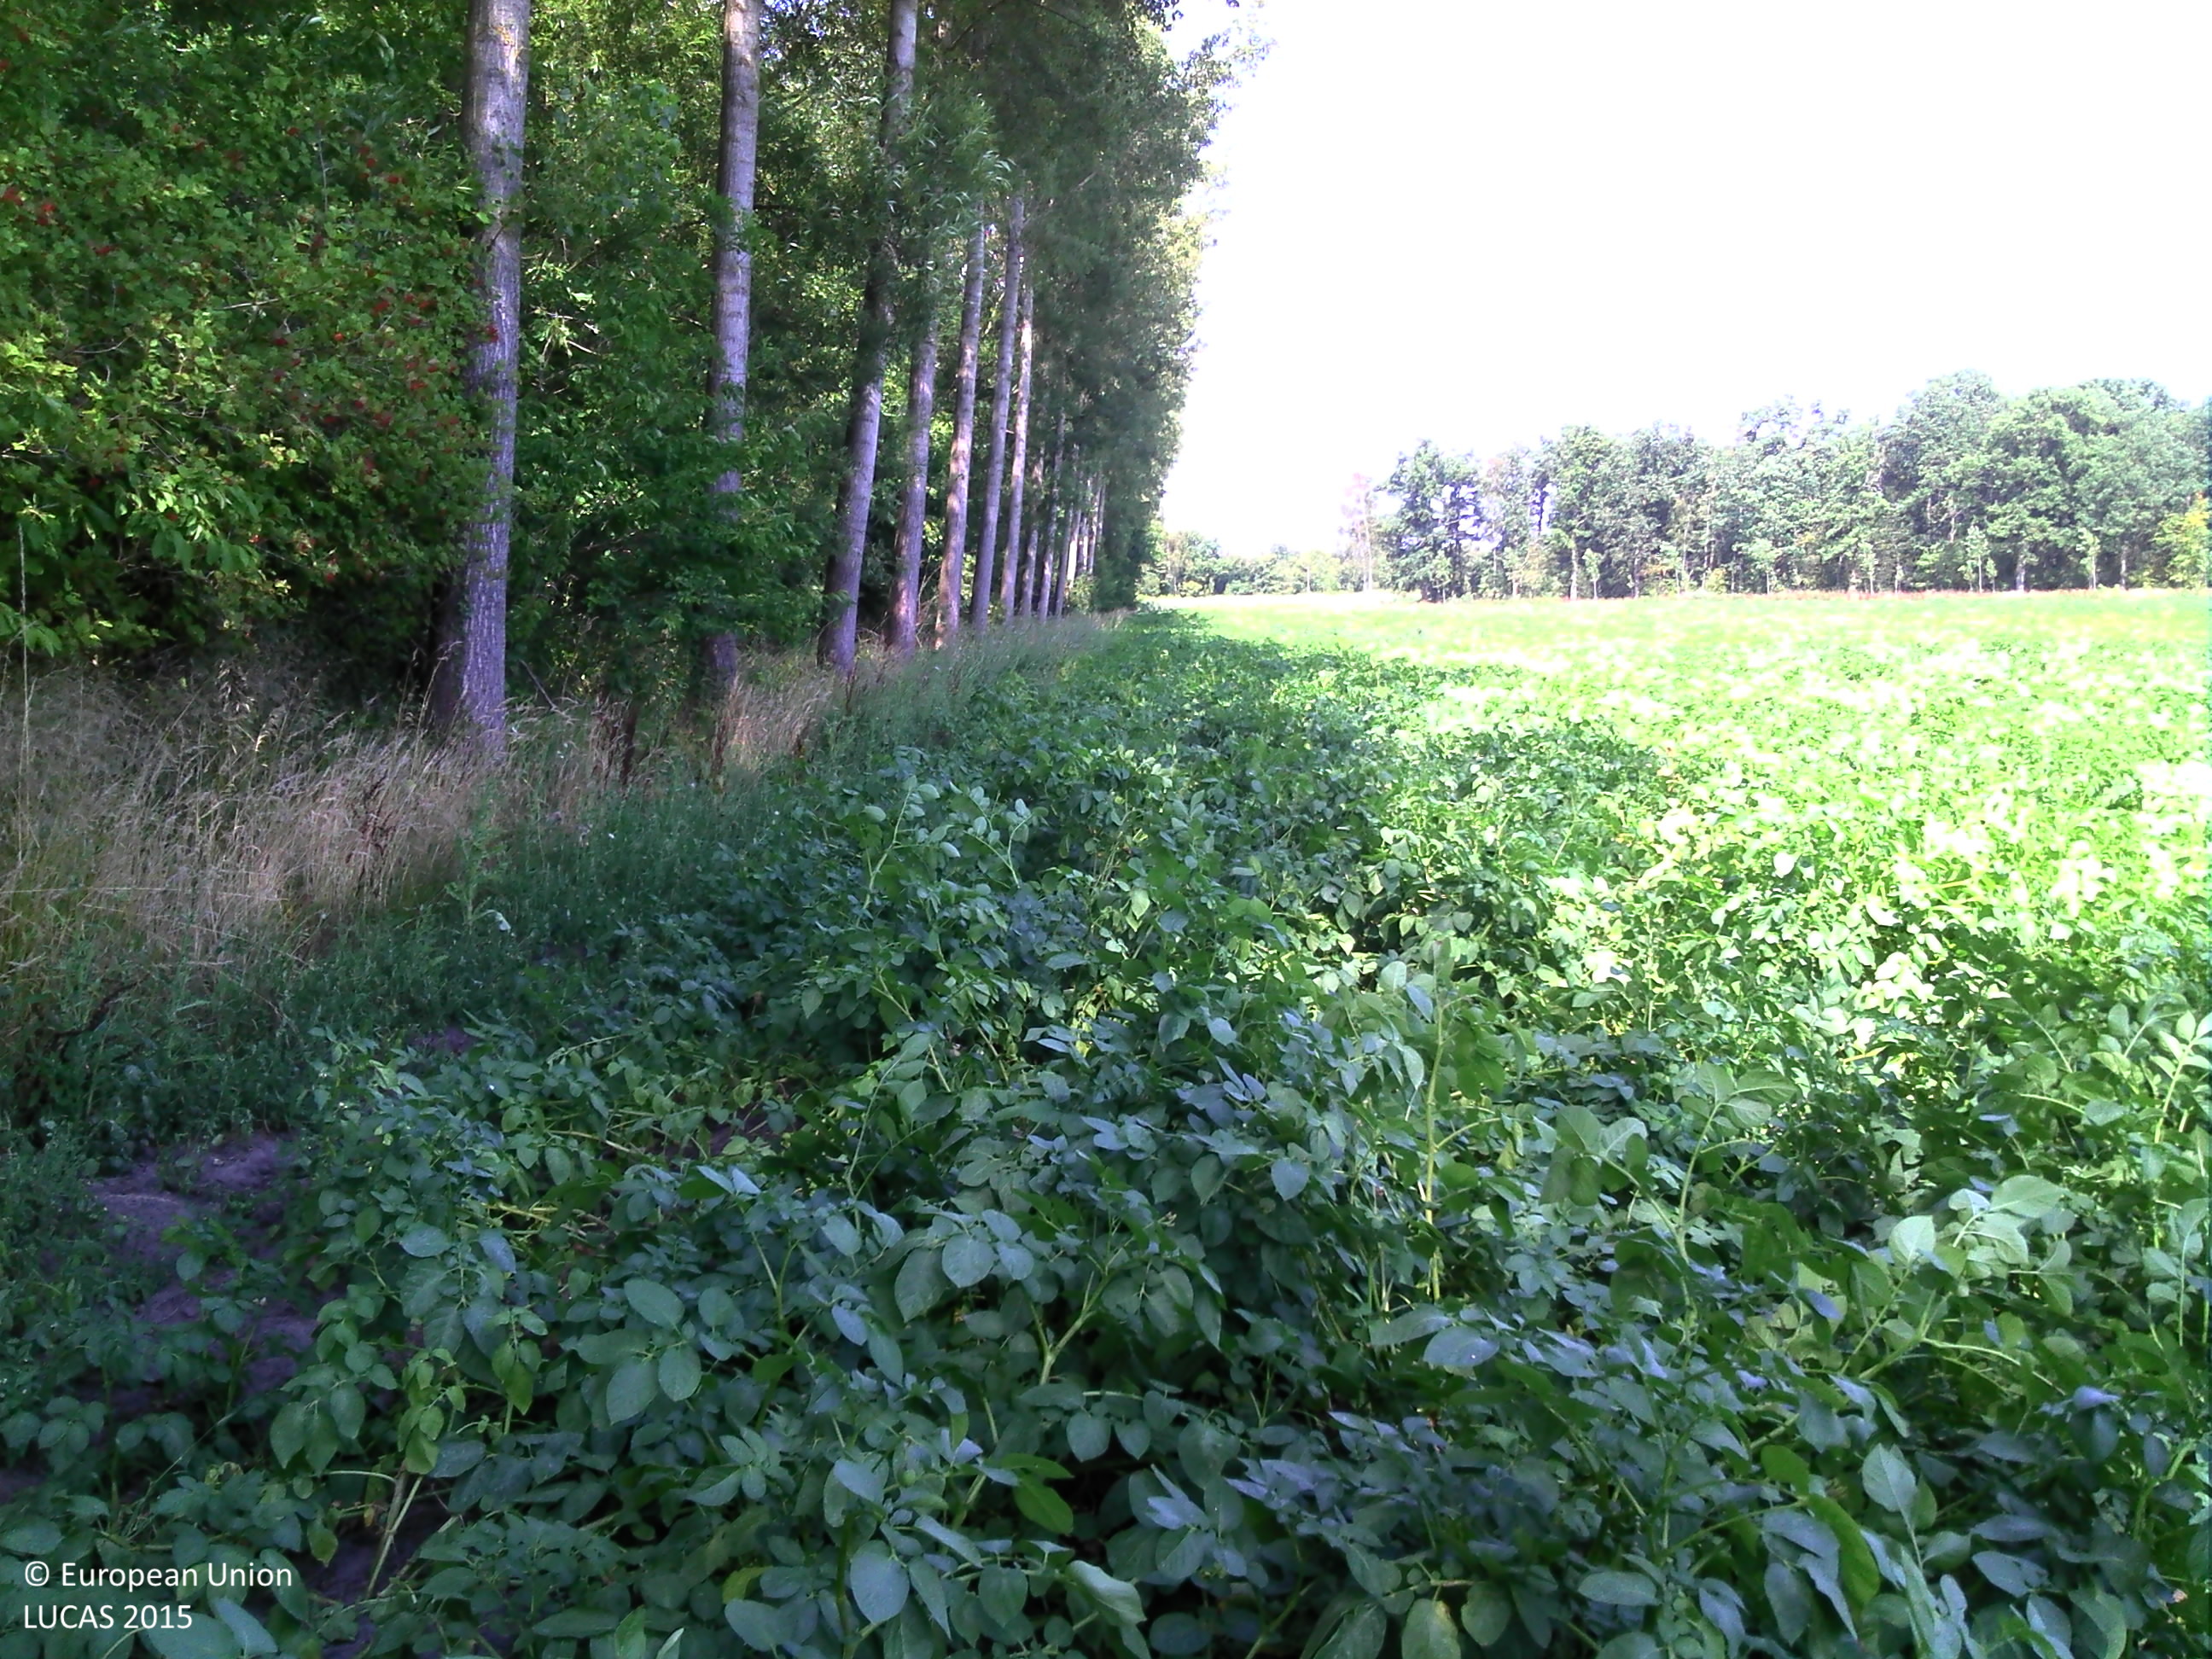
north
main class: Cropland
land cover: Potatoes
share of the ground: > 75 %
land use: Agriculture (excluding fallow land and kitchen gardens)
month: August
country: BE
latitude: 51.2317
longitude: 5.5443
